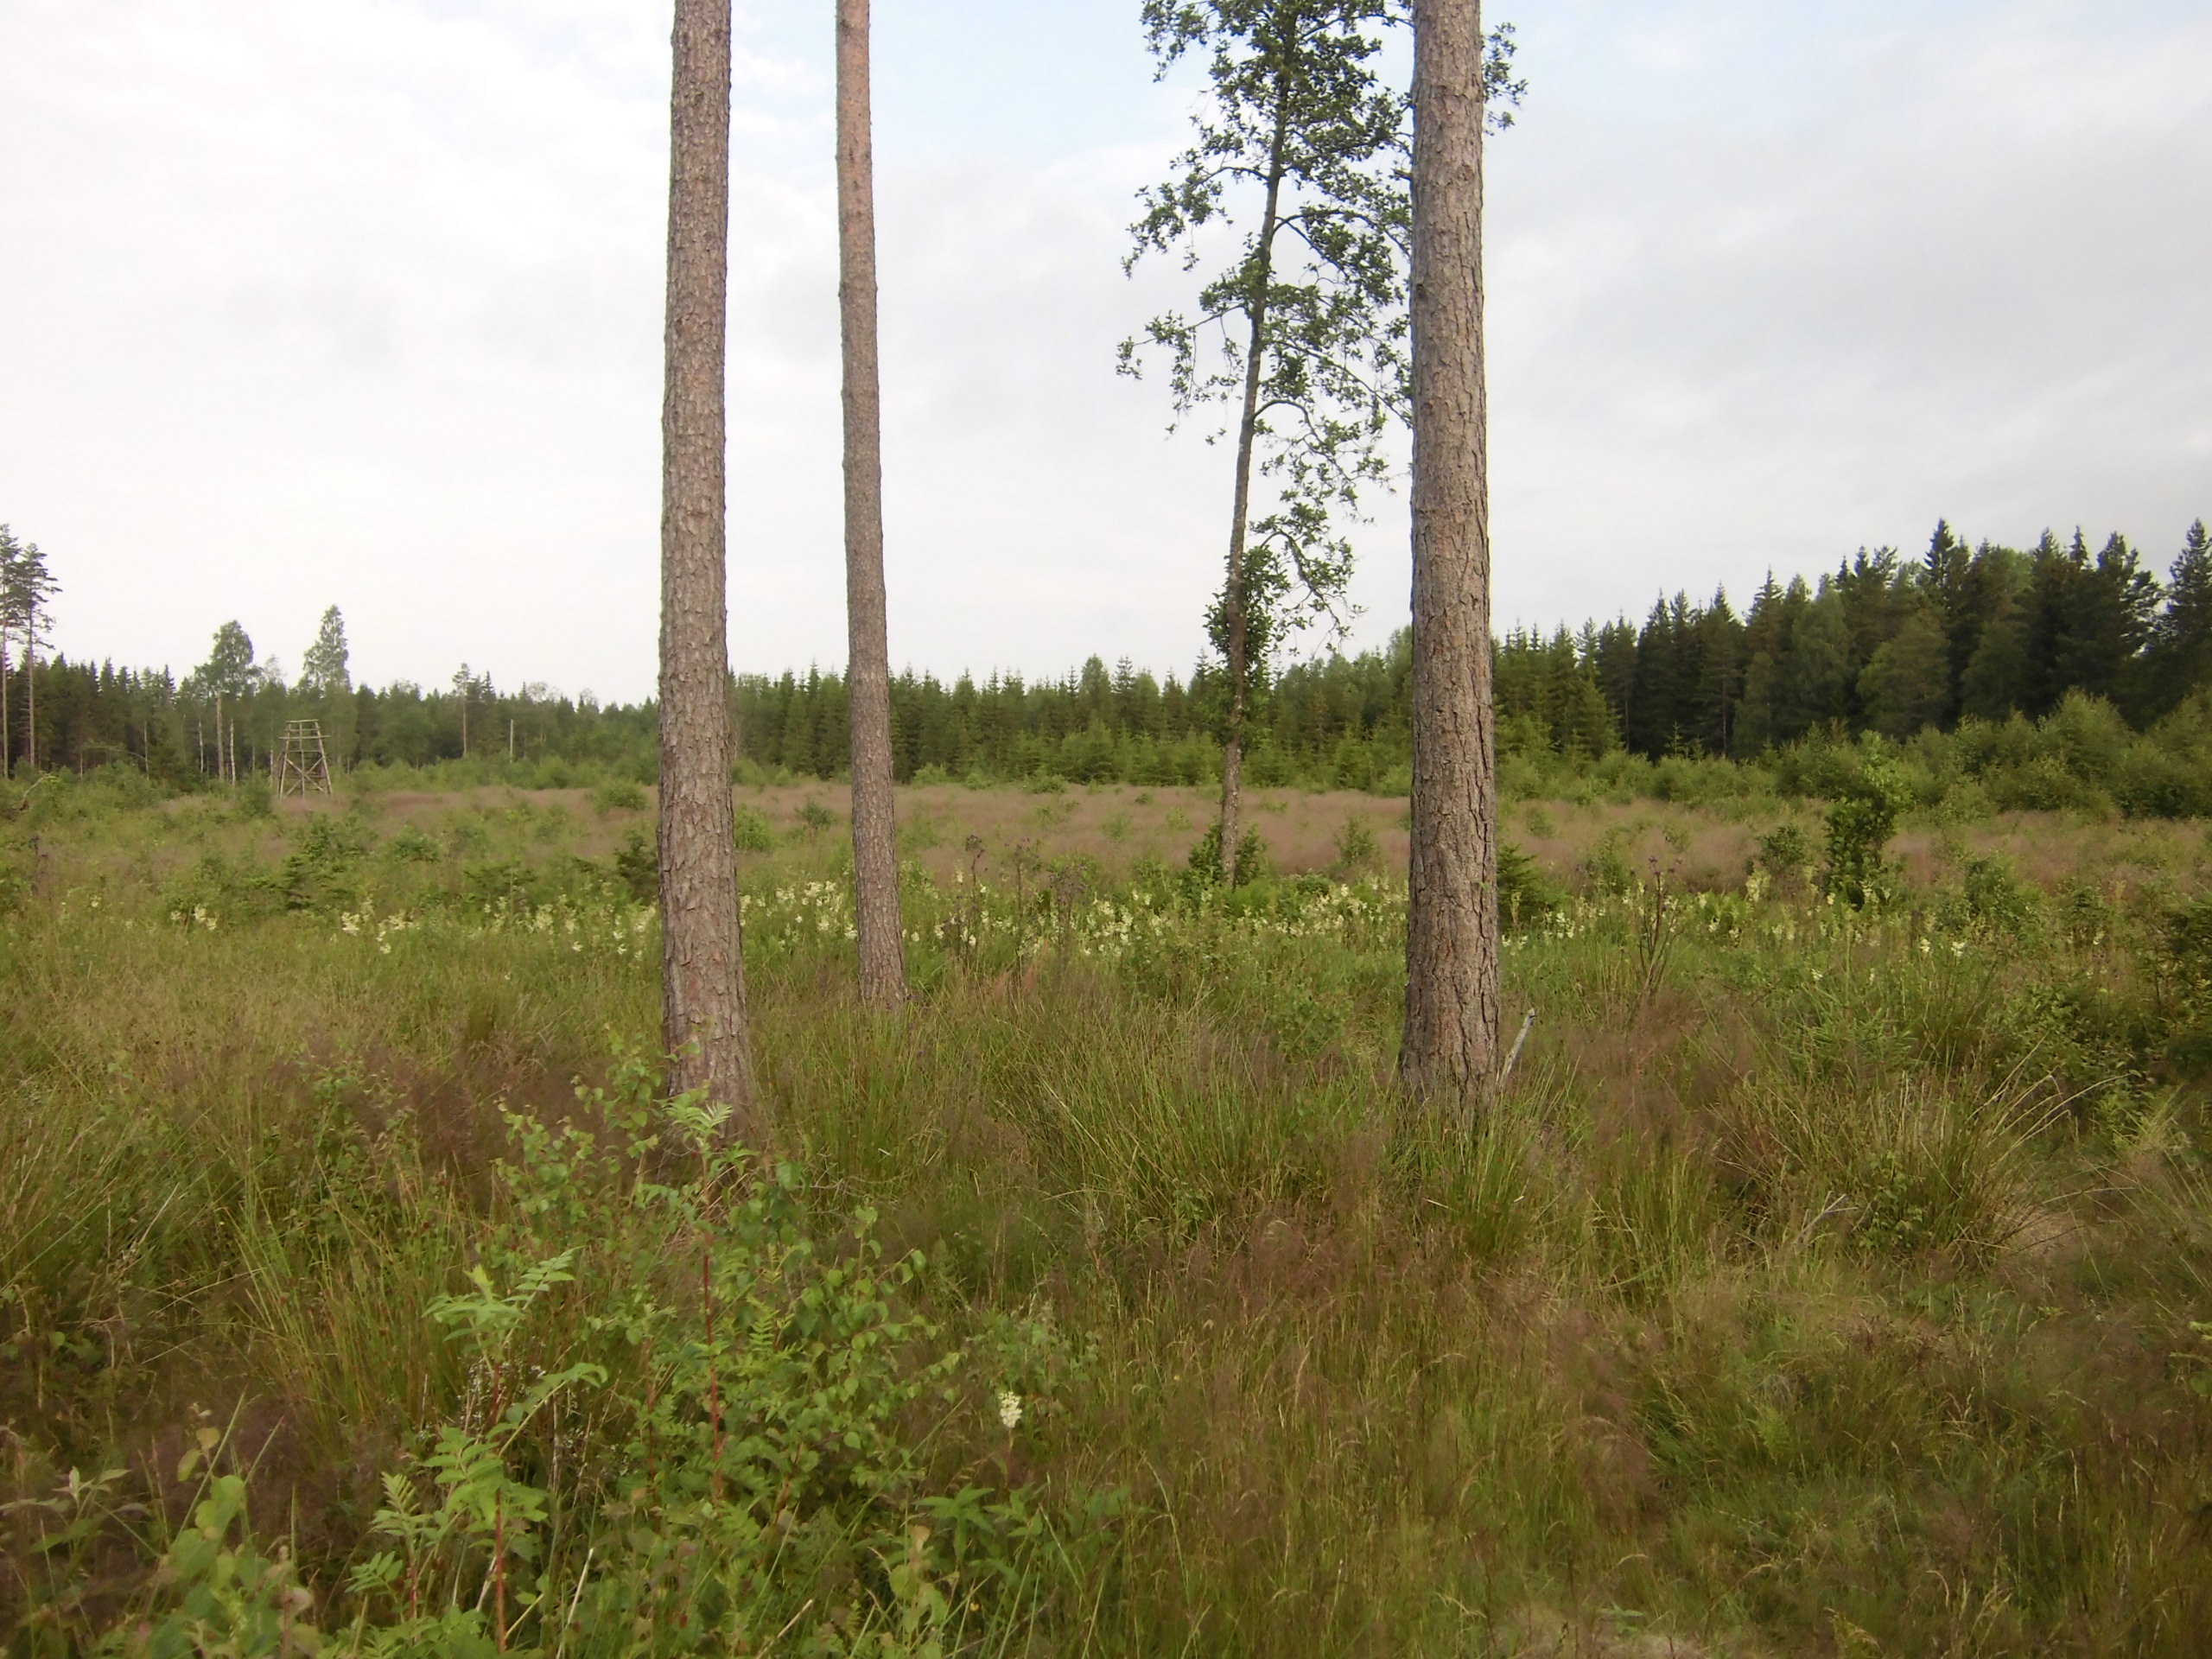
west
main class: Woodland
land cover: Pine dominated mixed woodland
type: boreal forest
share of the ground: 25 - 50 %
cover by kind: herbaceous plants 40 %, shrubs 25 %, broadleaved forest trees 15 %, coniferous forest trees 10 %, lichens and mosses 10 %
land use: Forestry
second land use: Amenities, museums, leisure
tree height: > 5 m
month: July
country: SE
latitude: 57.3937
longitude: 14.8380
